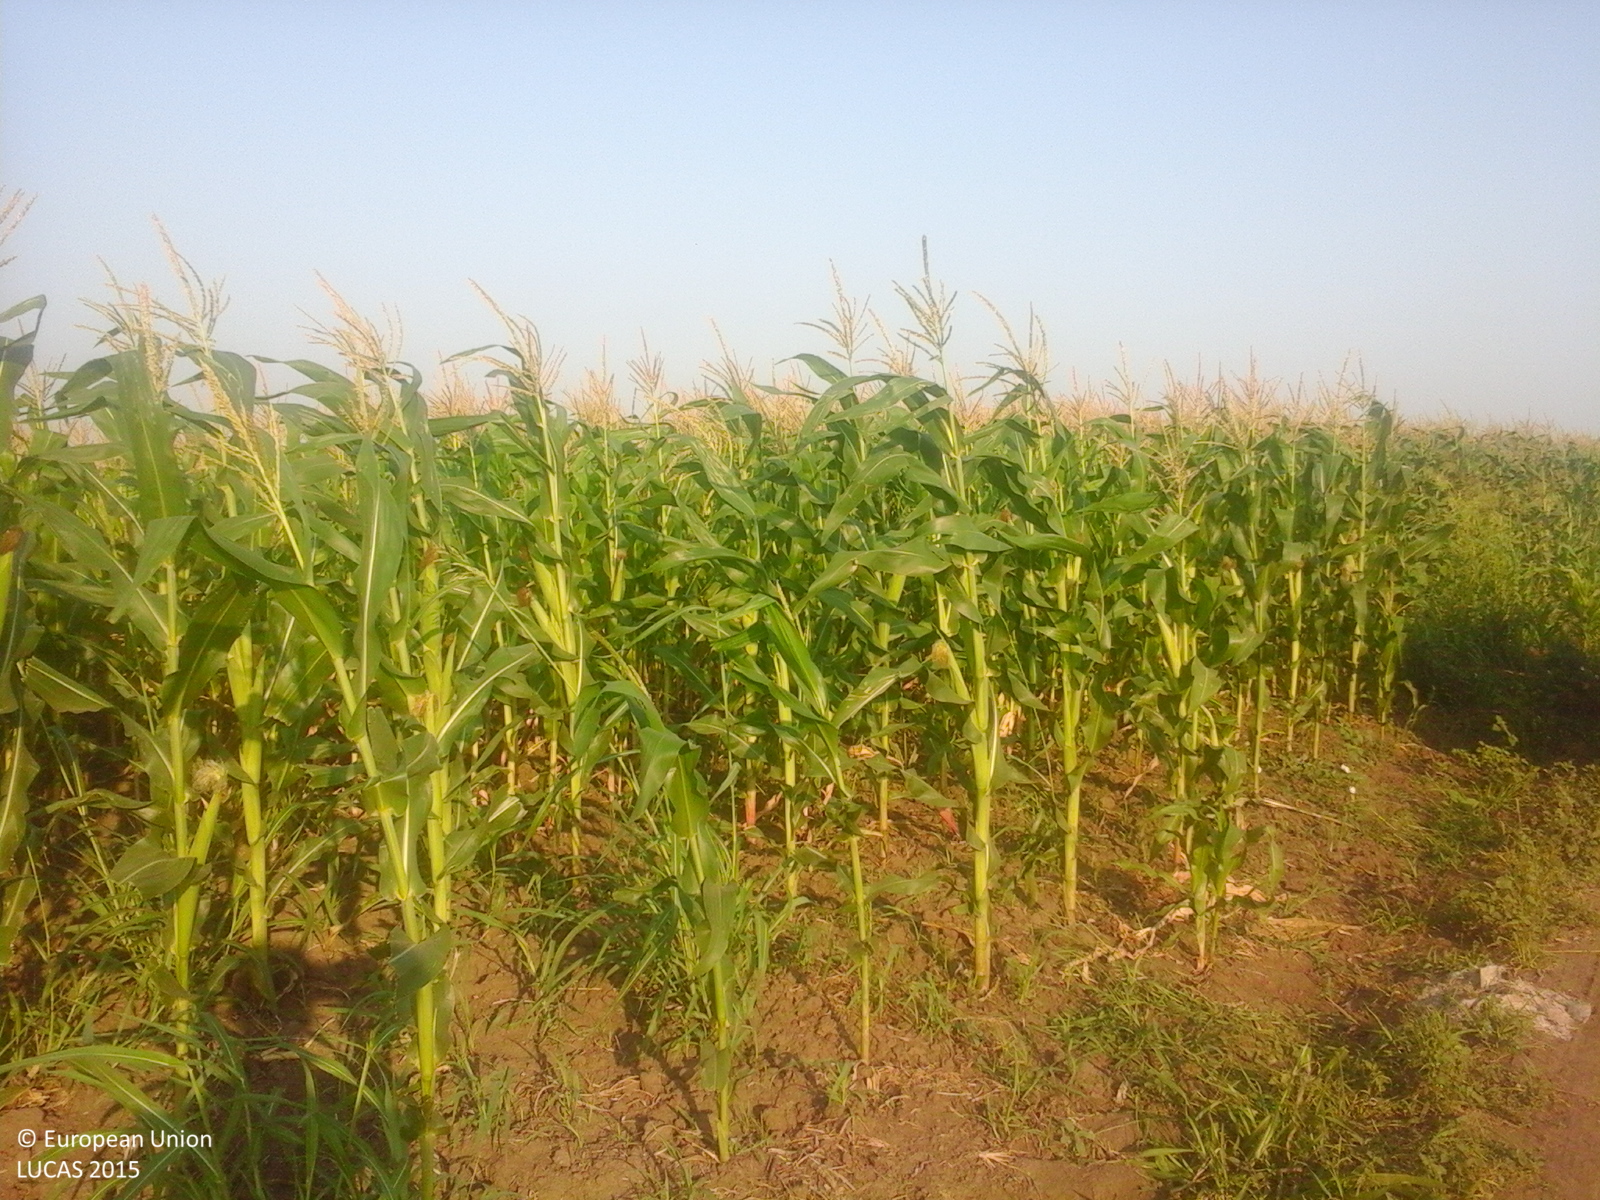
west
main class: Cropland
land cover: Sunflower
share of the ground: > 75 %
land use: Agriculture (excluding fallow land and kitchen gardens)
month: July
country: RO
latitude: 44.8221
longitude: 27.3806
